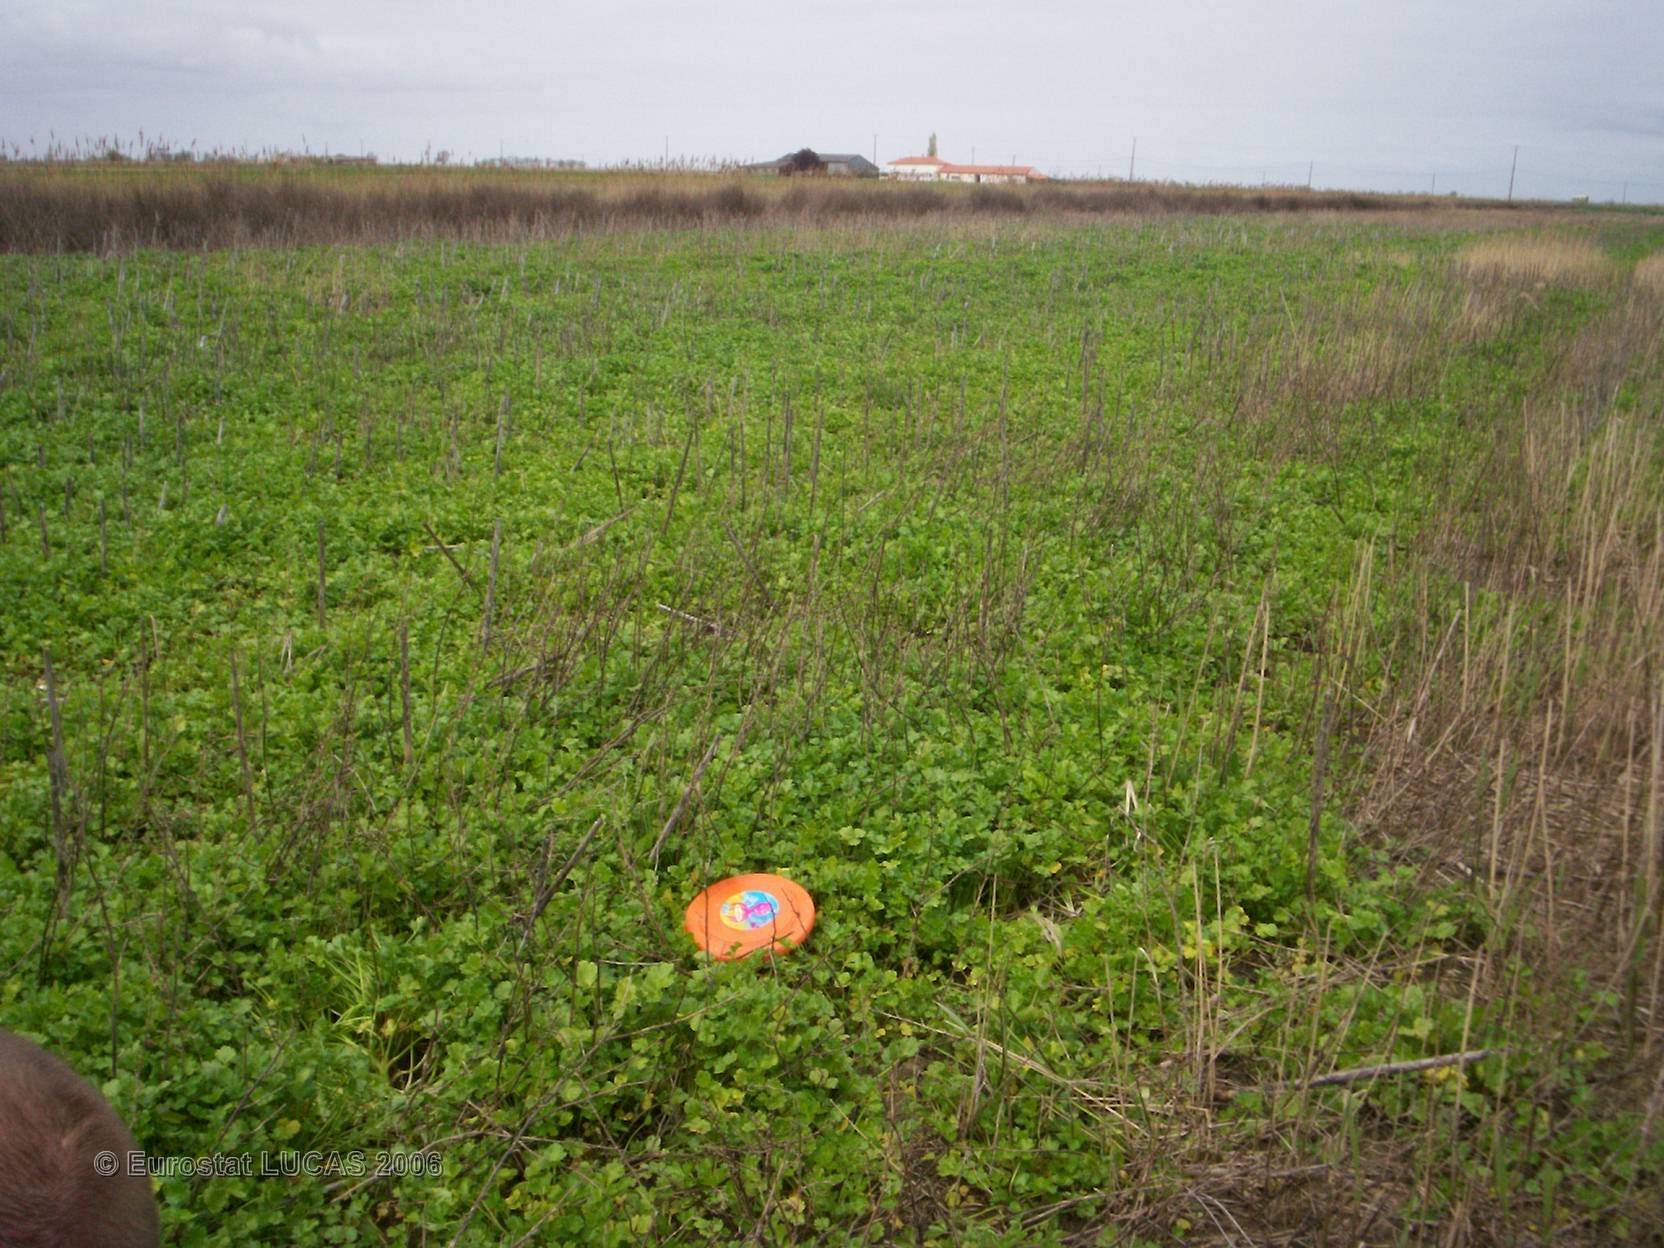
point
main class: Grassland
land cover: Grassland without tree/shrub cover
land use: Fallow land
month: April
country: FR
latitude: 45.3580
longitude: -0.7076
